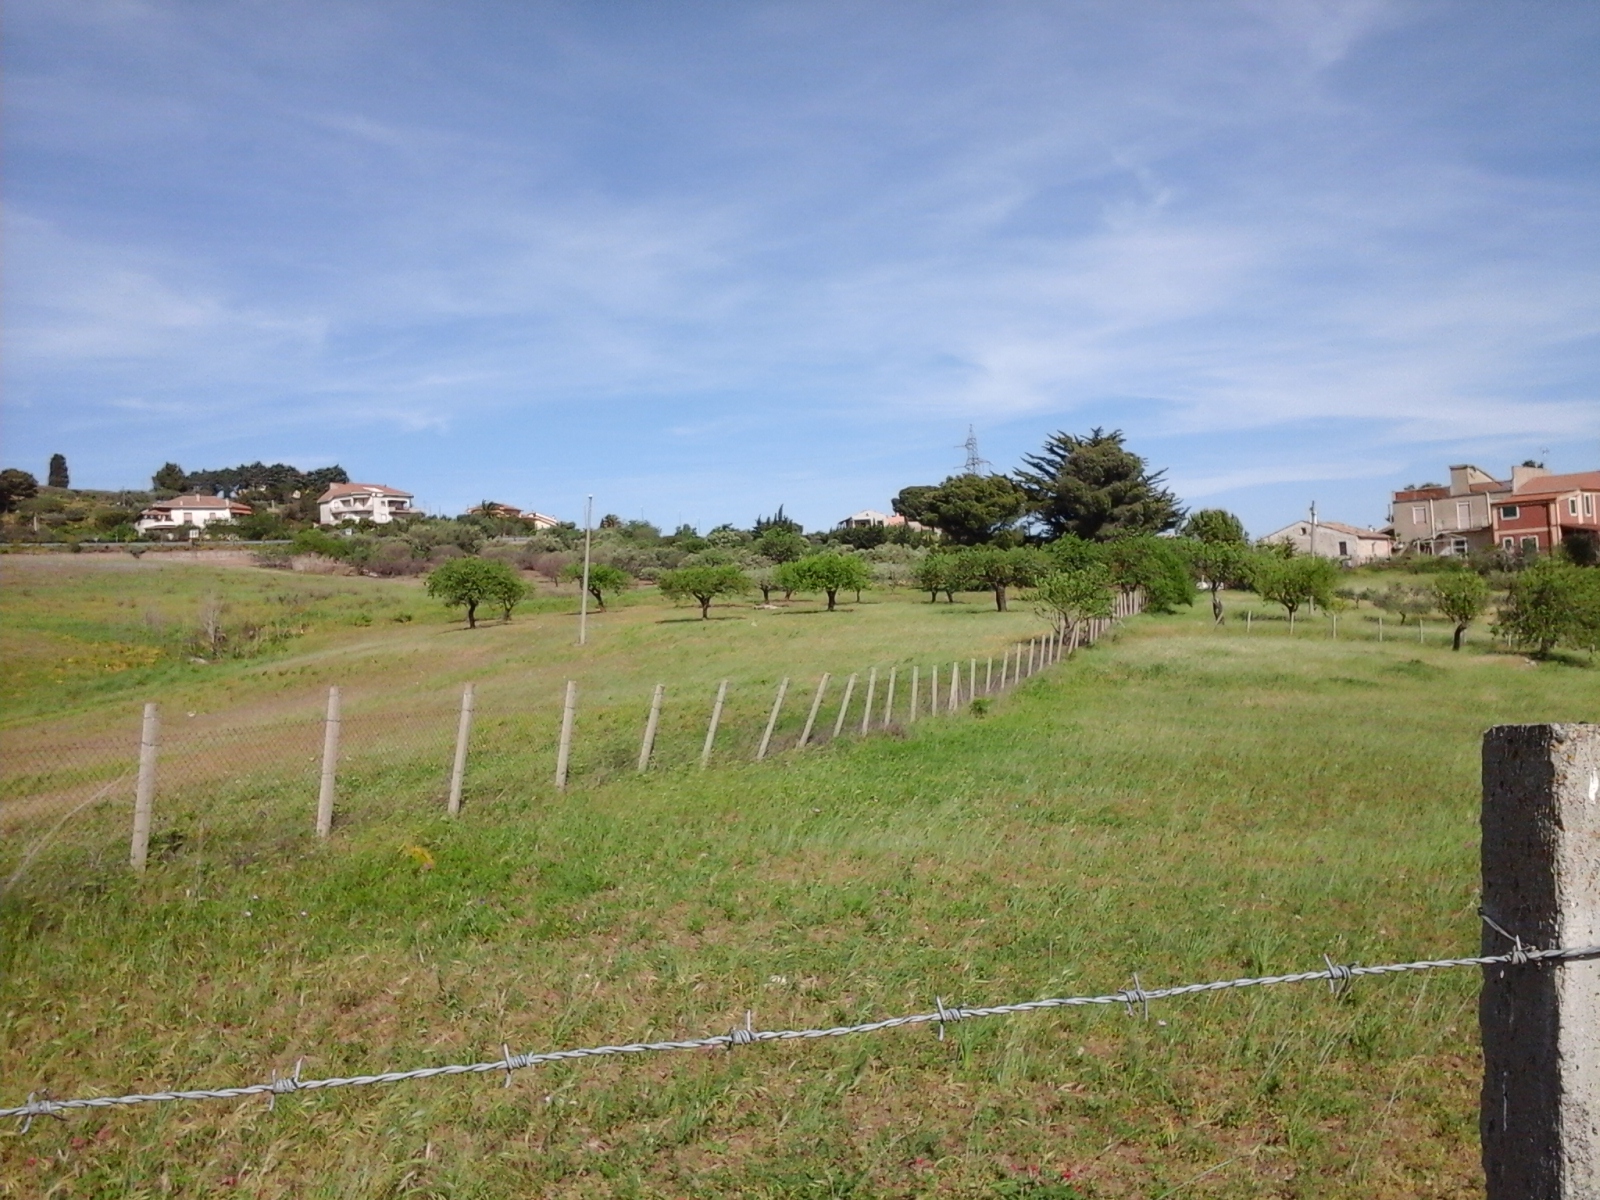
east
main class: Grassland
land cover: Spontaneously vegetated surfaces
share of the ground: > 75 %
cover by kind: herbaceous plants 100 %
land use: Fallow land
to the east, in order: Spontaneously vegetated surfaces; Fences; Spontaneously vegetated surfaces; Electric lines; Nuts trees; Olive groves; Grass margins; Olive groves
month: May
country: IT
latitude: 37.4813
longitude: 14.0071
